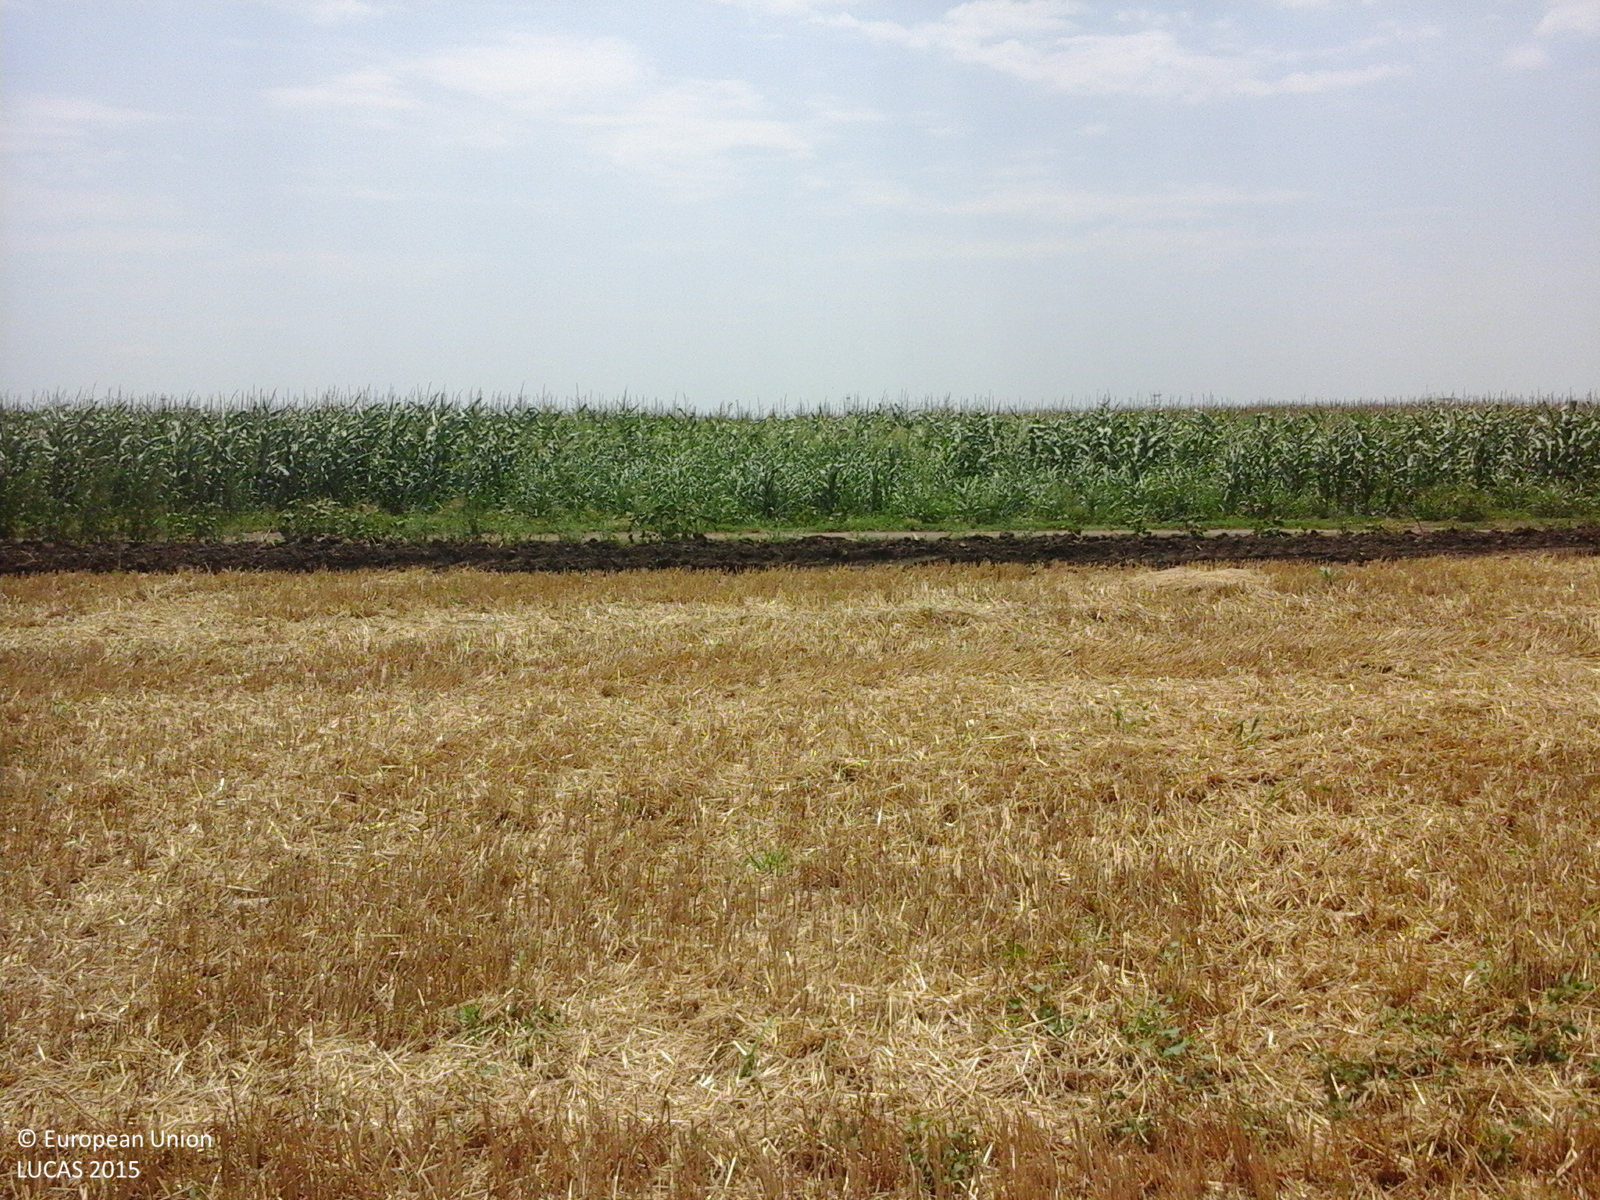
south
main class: Cropland
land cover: Common wheat
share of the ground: > 75 %
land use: Agriculture (excluding fallow land and kitchen gardens)
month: July
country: RO
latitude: 44.6705
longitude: 27.5144
